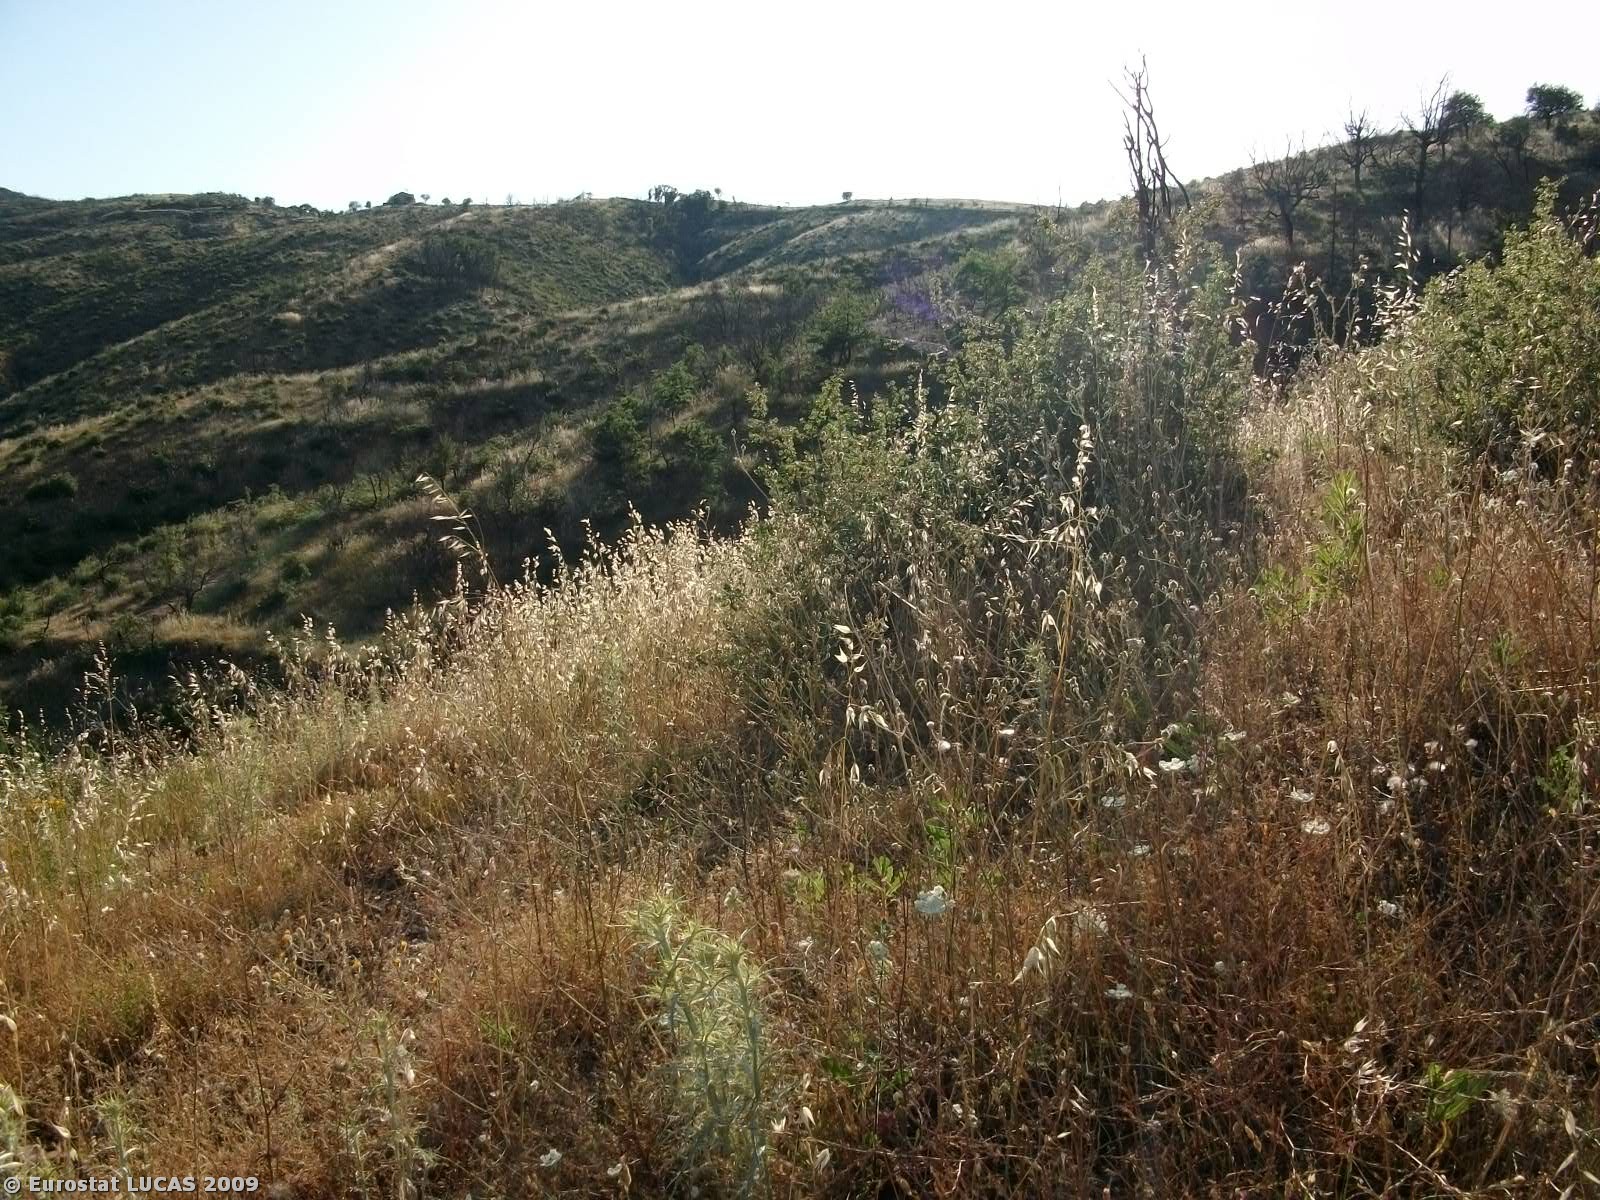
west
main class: Woodland
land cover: Broadleaved woodland
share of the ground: 50 - 75 %
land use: Forestry
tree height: < 5 m
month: June
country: GR
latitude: 37.2920
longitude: 22.1741
